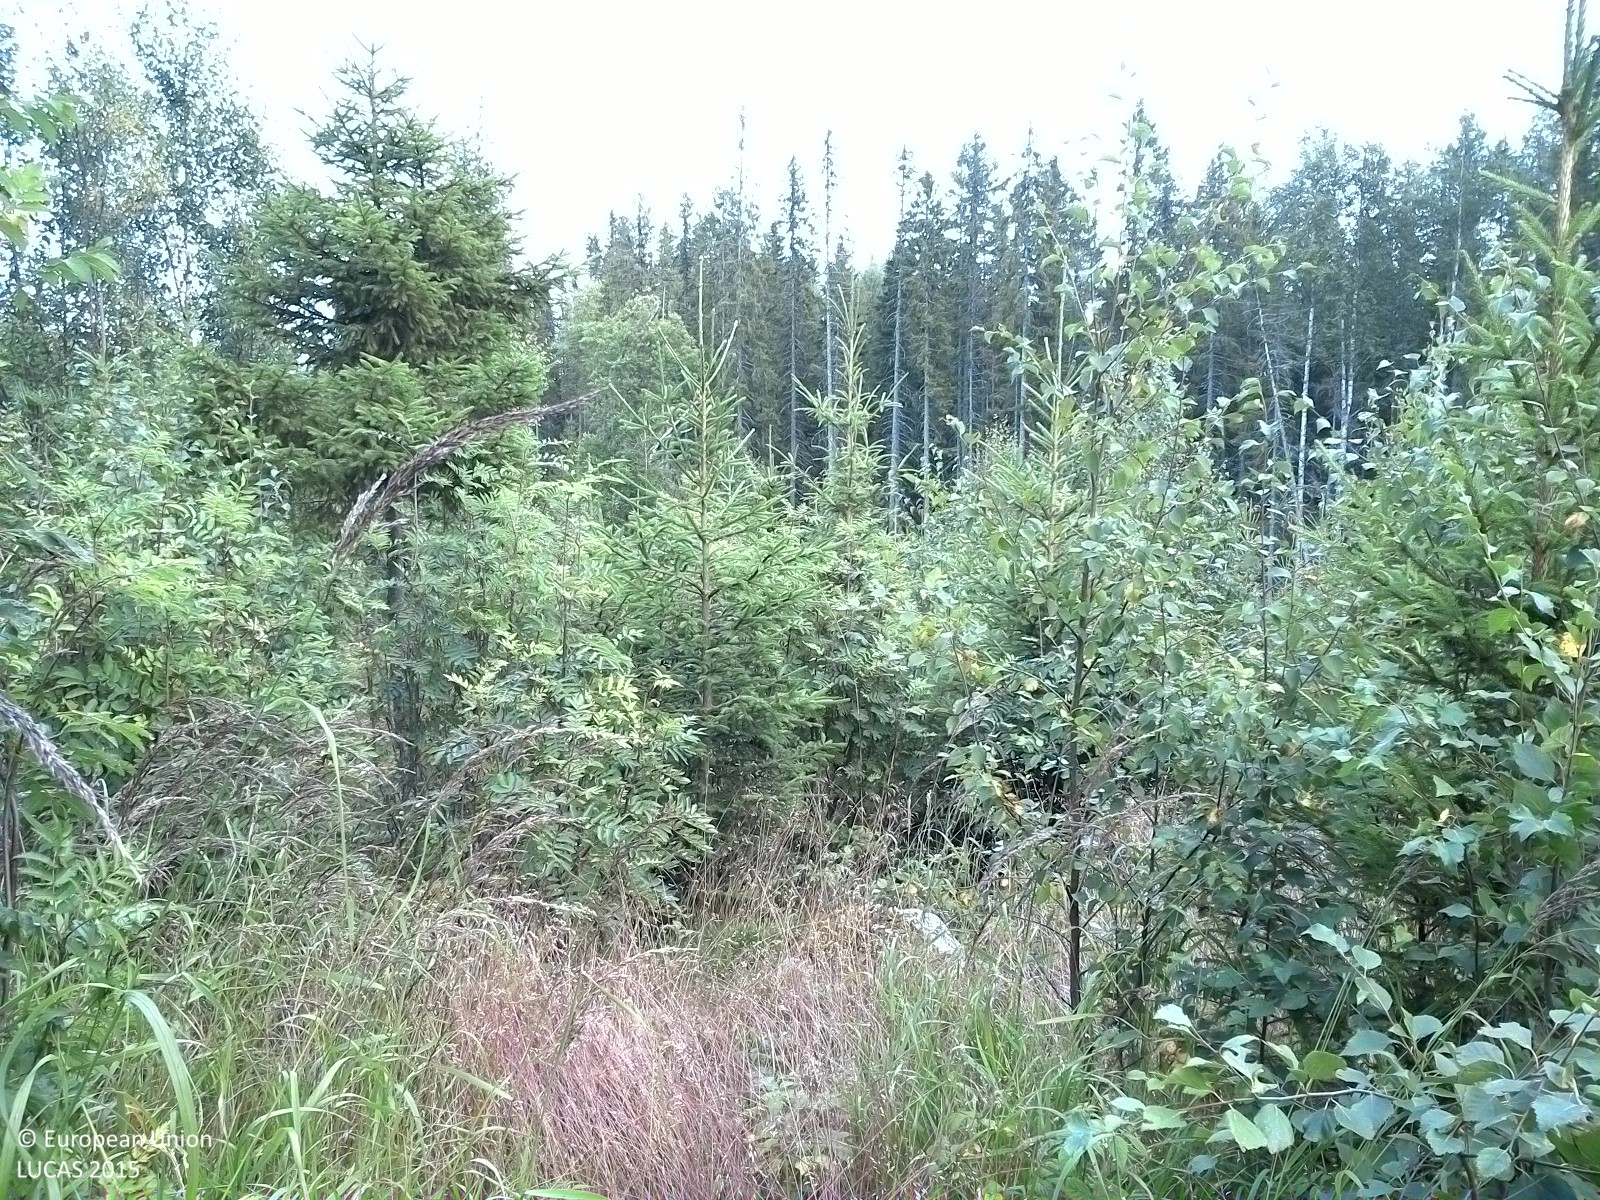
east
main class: Woodland
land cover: Spruce dominated mixed woodland
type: boreal forest
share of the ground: 50 - 75 %
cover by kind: broadleaved forest trees 35 %, herbaceous plants 25 %, coniferous forest trees 20 %, shrubs 20 %
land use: Forestry
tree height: < 5 m
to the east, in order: Spruce dominated mixed woodland; Broadleaved woodland; Spruce dominated mixed woodland; Spruce dominated coniferous woodland; Grass margins; Paved roads, cycling and walking lanes; Grass margins; Spruce dominated mixed woodland
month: August
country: SE
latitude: 62.3604
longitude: 16.1437
